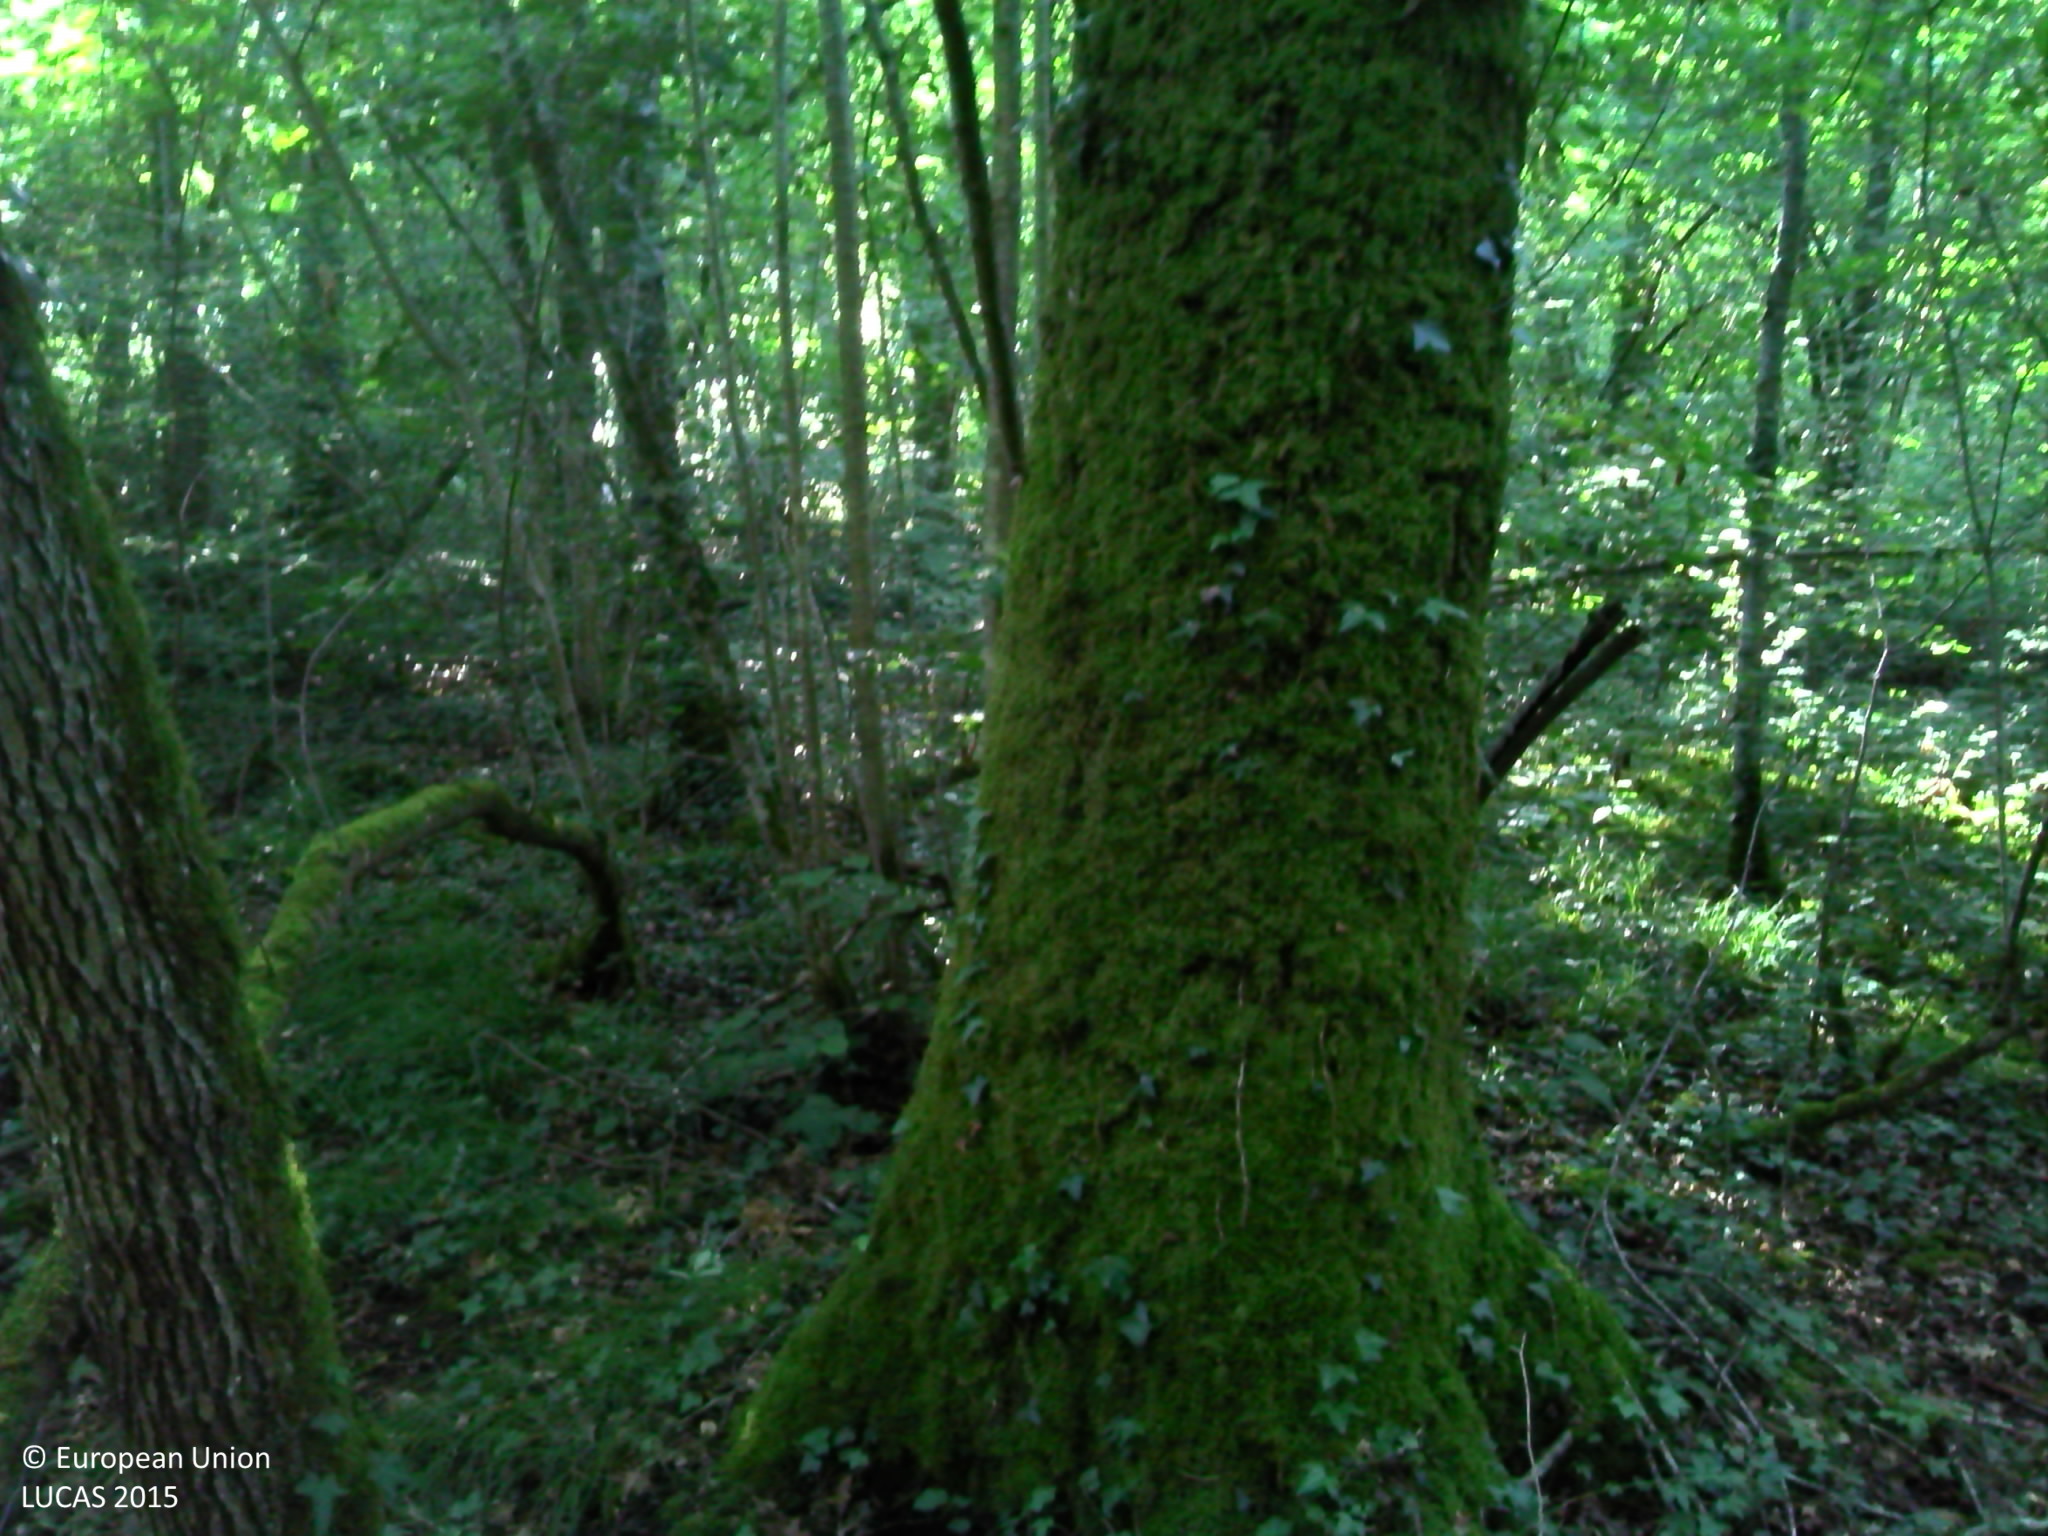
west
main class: Woodland
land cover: Broadleaved woodland
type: mesophytic deciduous forest
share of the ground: > 75 %
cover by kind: broadleaved forest trees 100 %
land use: Forestry
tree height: > 5 m
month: August
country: FR
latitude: 47.1793
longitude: 2.0868
